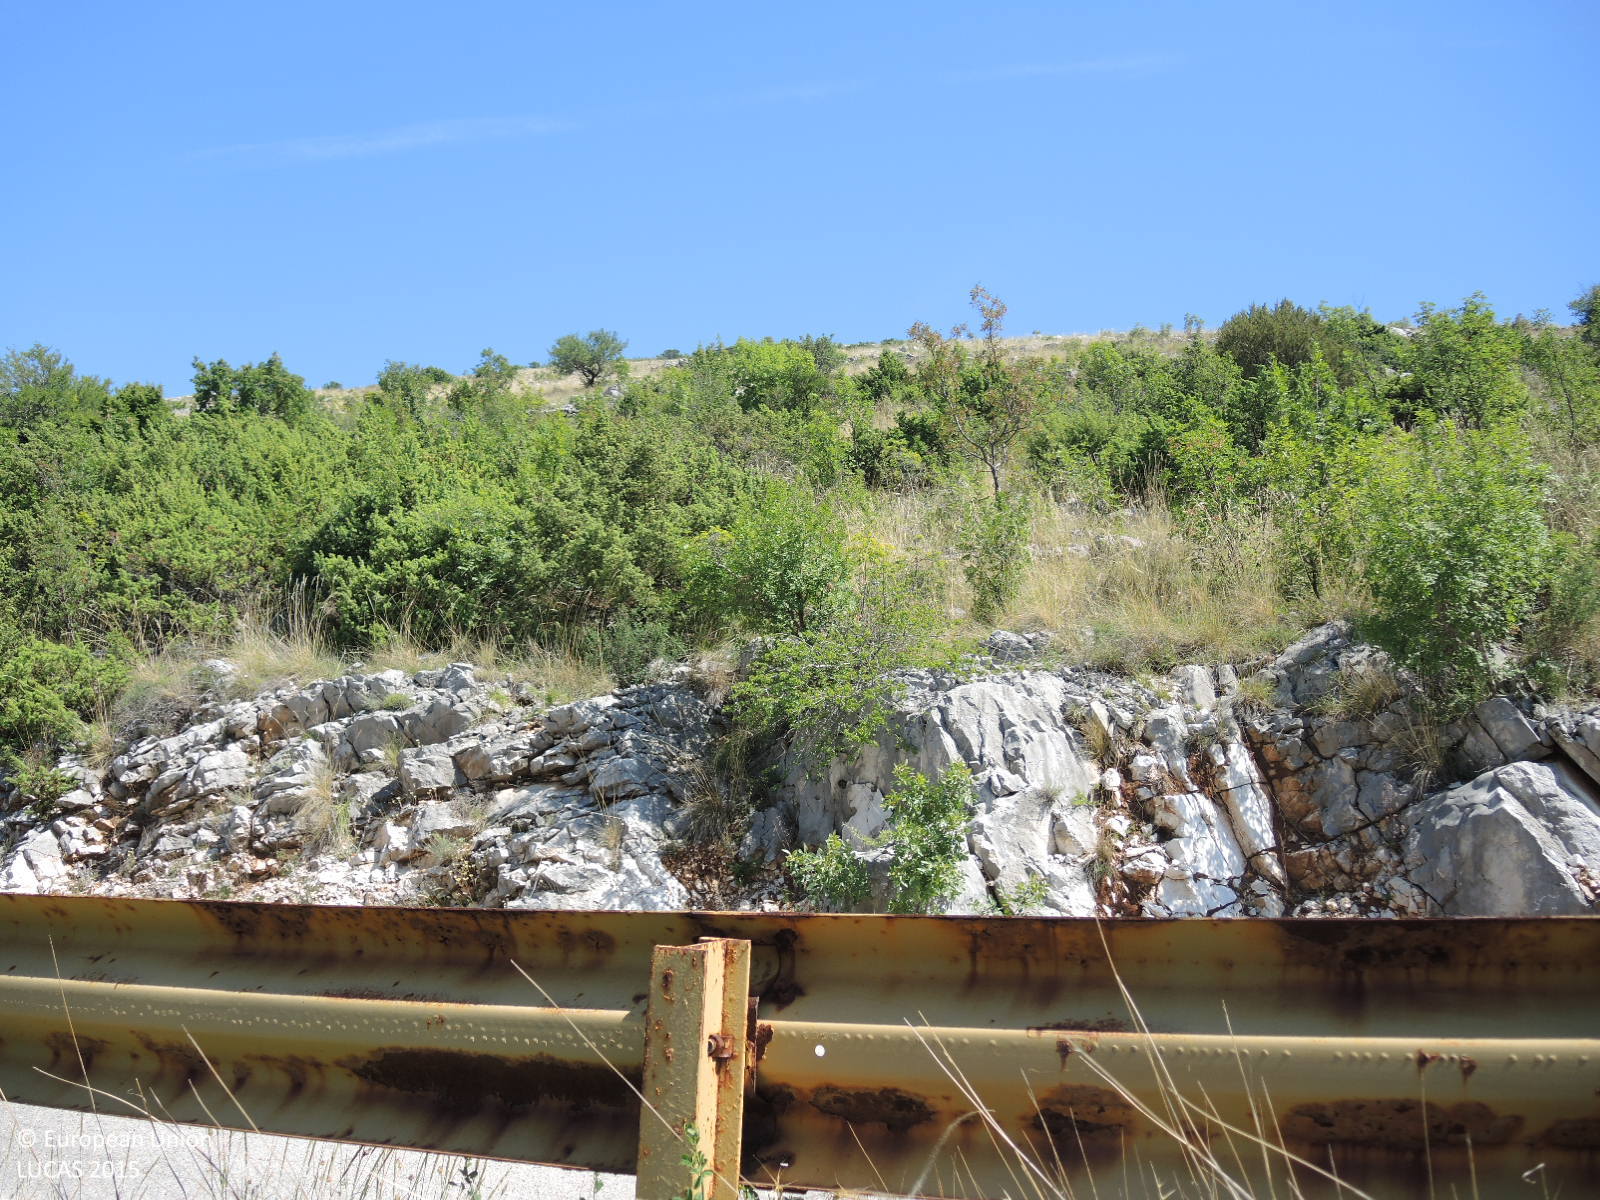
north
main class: Shrubland
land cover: Shrubland with sparse tree cover
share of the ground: 25 - 50 %
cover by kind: shrubs 45 %, herbaceous plants 20 %, unconsolidated bare surface 20 %, consolidated bare surface 10 %, broadleaved forest trees 5 %
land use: Semi-natural and natural areas not in use
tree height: < 5 m
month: June
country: HR
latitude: 43.6210
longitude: 16.2243
